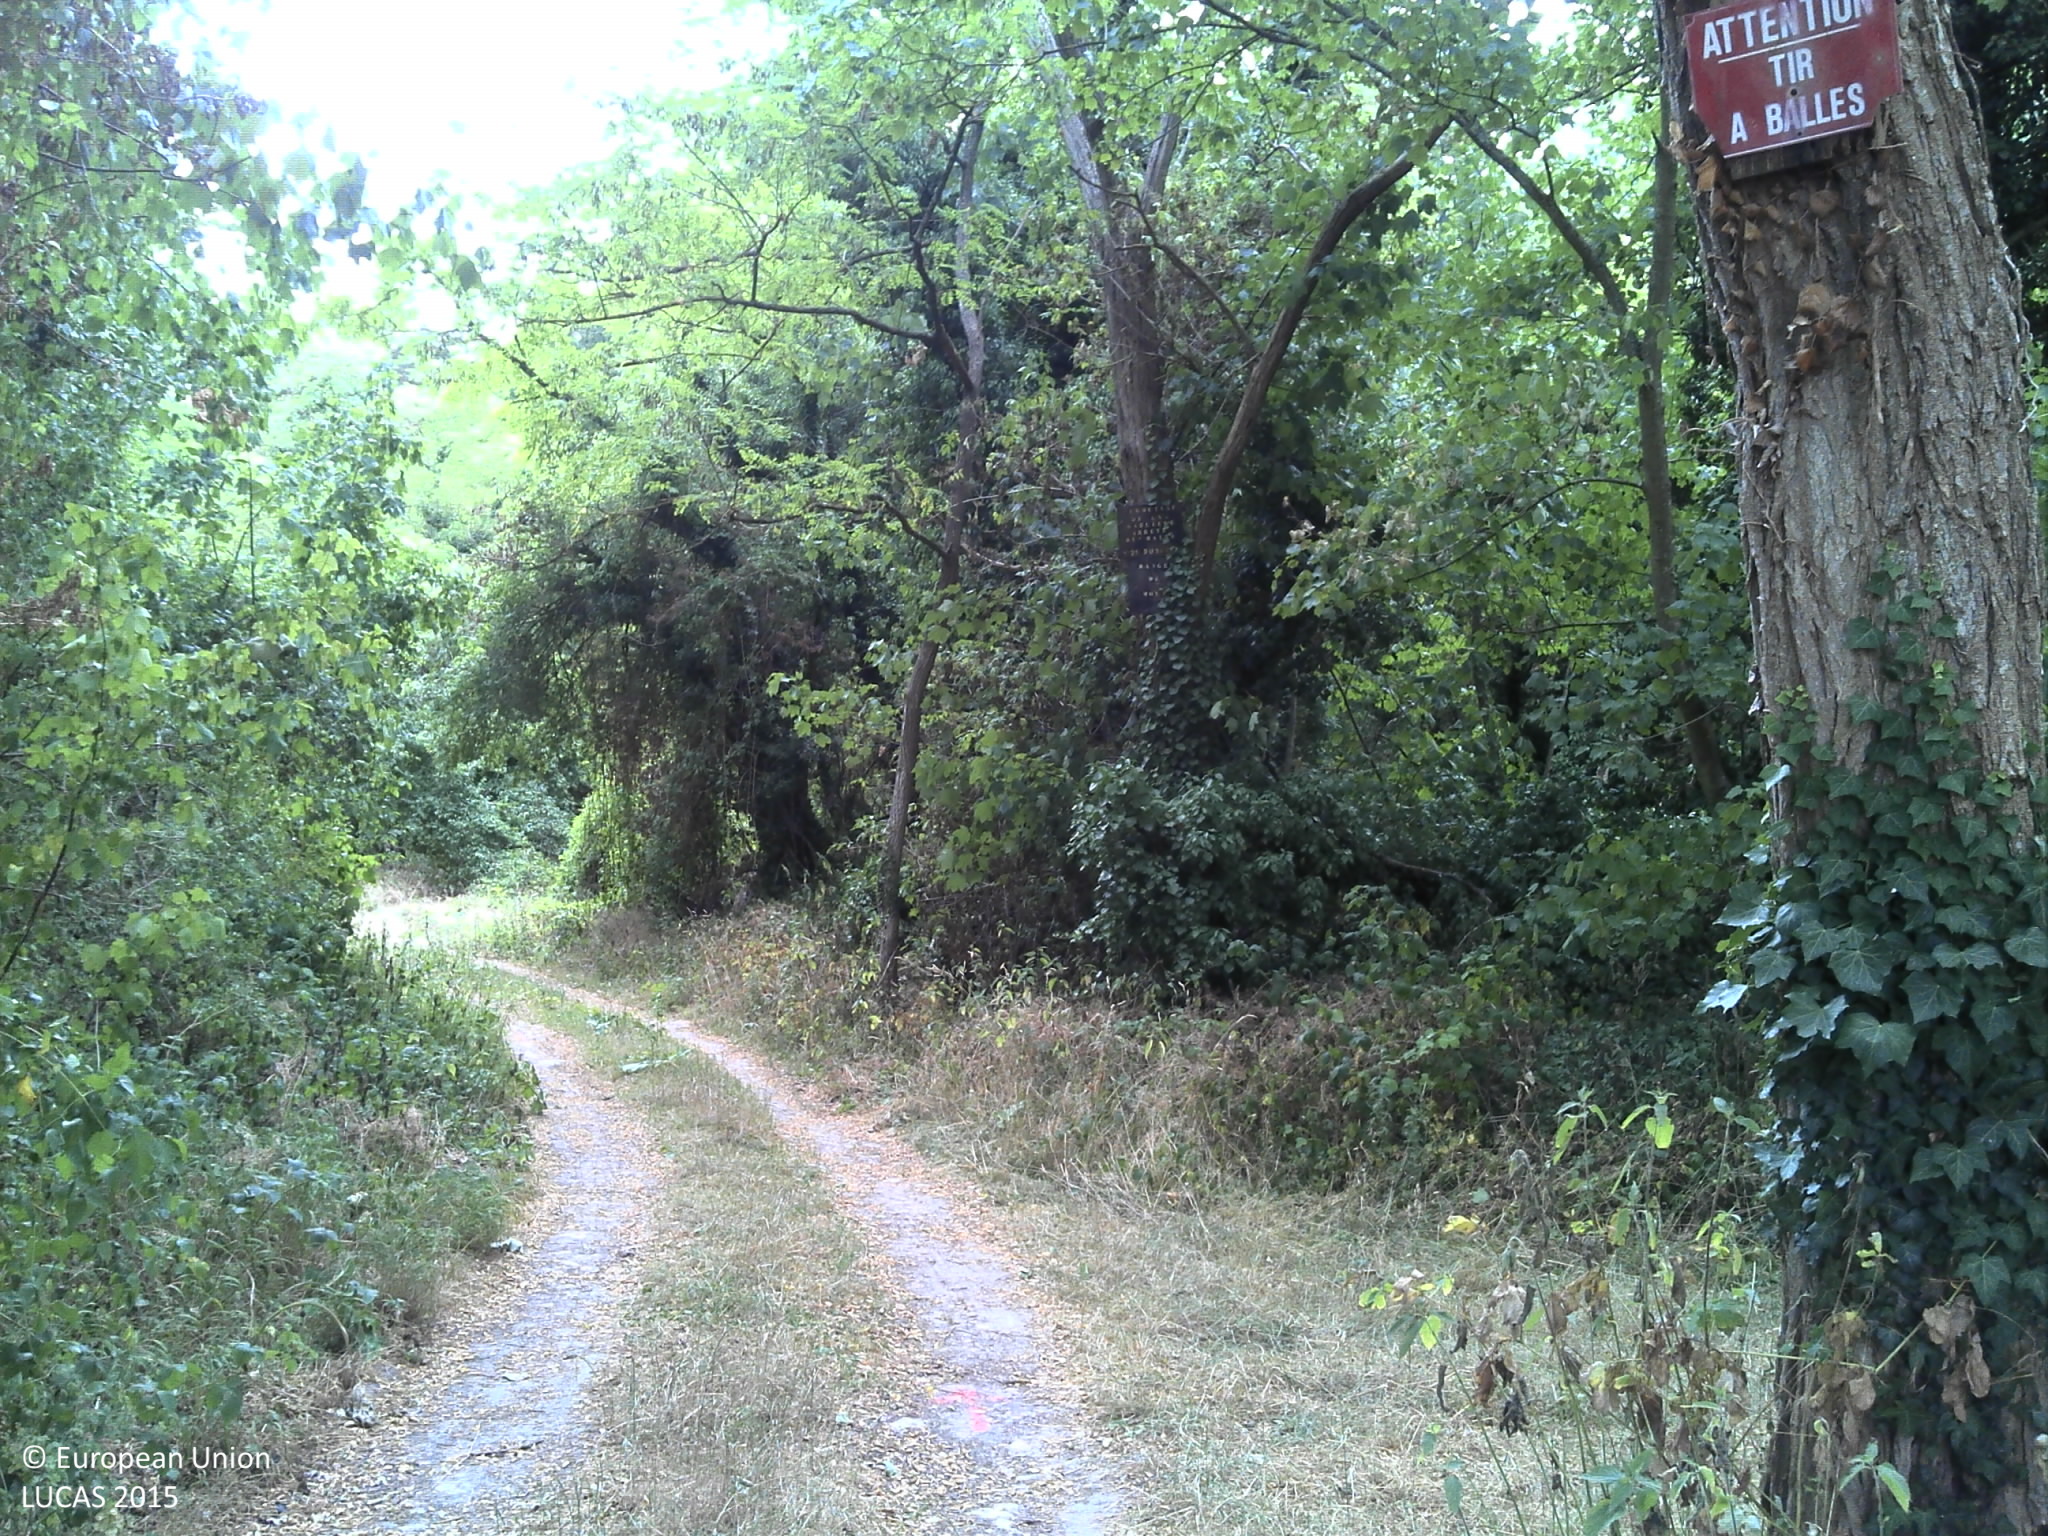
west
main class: Woodland
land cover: Broadleaved woodland
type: mesophytic deciduous forest
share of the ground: > 75 %
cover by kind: broadleaved forest trees 90 %, herbaceous plants 10 %
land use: Forestry
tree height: > 5 m
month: July
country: FR
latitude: 48.4529
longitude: 2.4579
